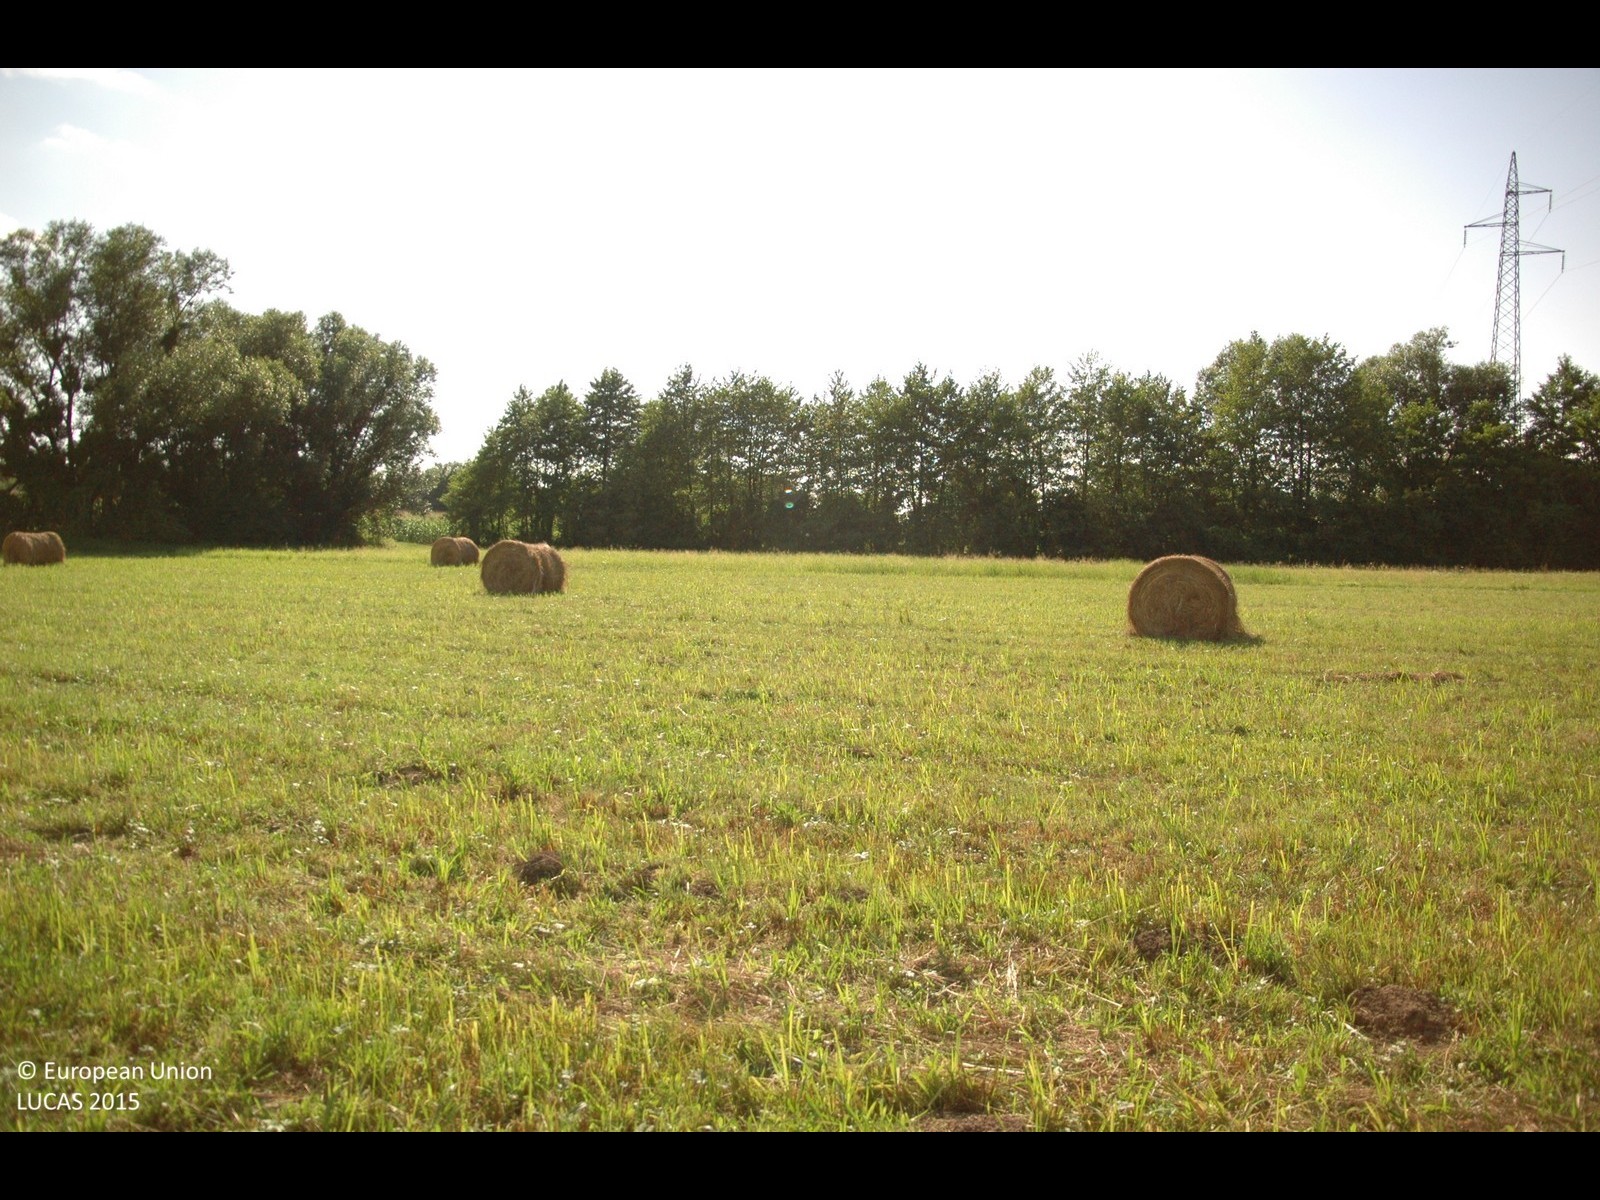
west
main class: Grassland
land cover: Grassland without tree/shrub cover
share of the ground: > 75 %
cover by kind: herbaceous plants 100 %
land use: Agriculture (excluding fallow land and kitchen gardens)
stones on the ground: < 10 %
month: July
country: HR
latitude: 46.2295
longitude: 16.7305
